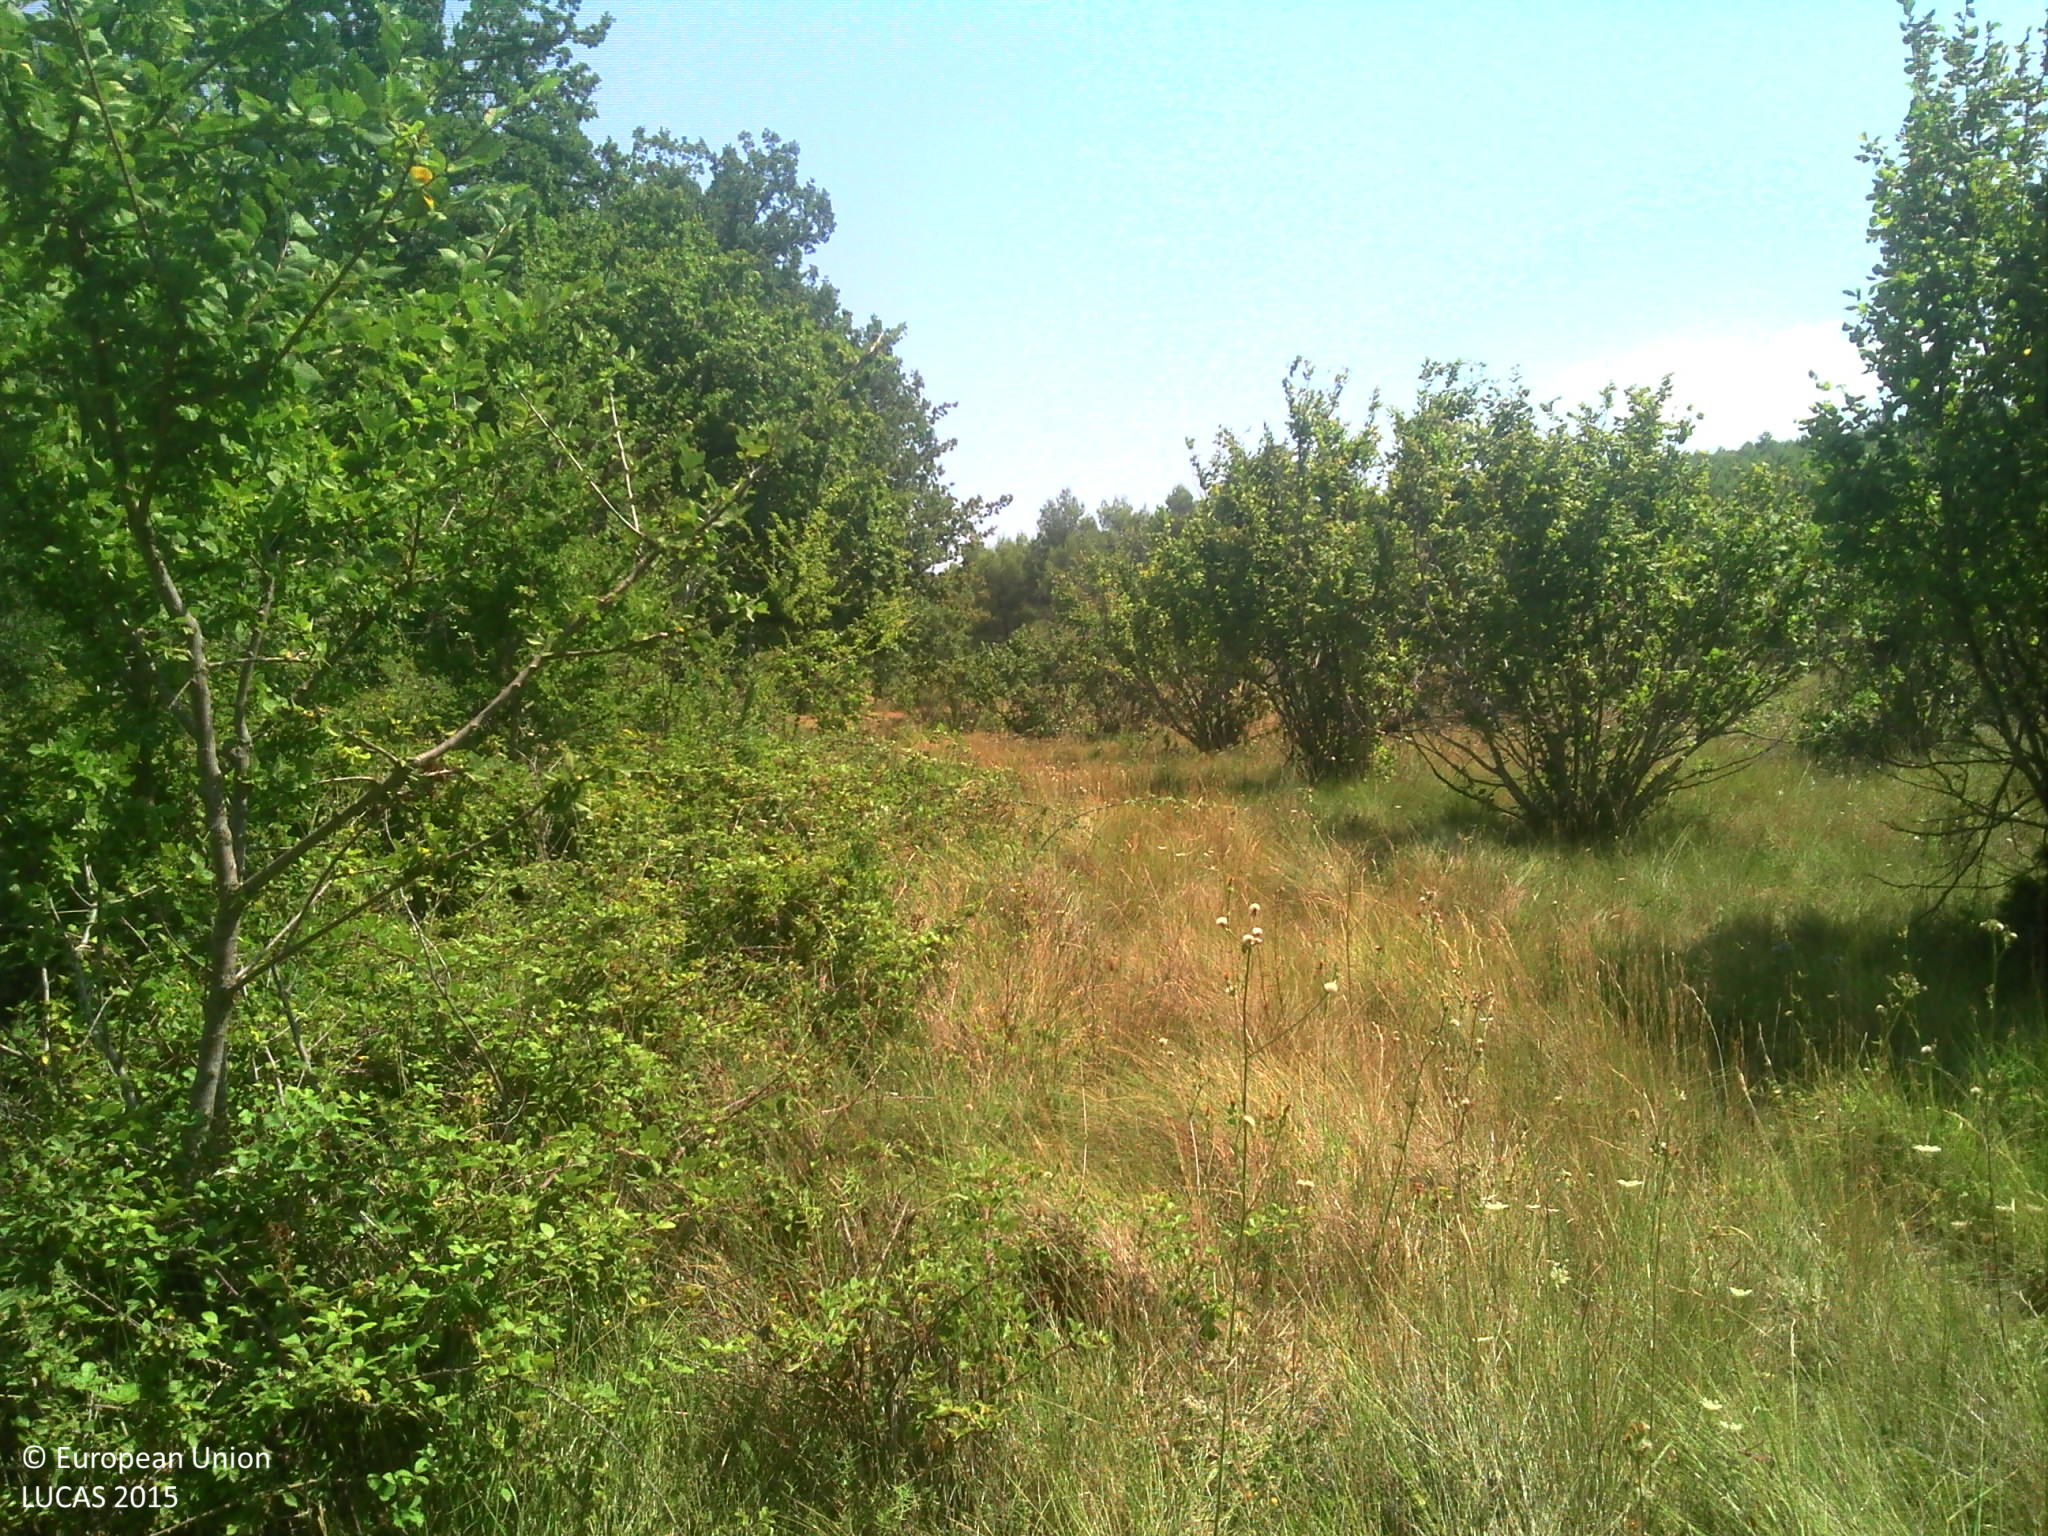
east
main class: Woodland
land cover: Broadleaved woodland
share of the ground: > 75 %
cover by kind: broadleaved forest trees 60 %, herbaceous plants 30 %, unconsolidated bare surface 10 %
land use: Forestry
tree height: > 5 m
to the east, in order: Broadleaved woodland; Rivers and streams; Broadleaved woodland; Tracks; Broadleaved woodland; Tracks; Broadleaved woodland
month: August
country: FR
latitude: 43.5163
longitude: 5.5932
